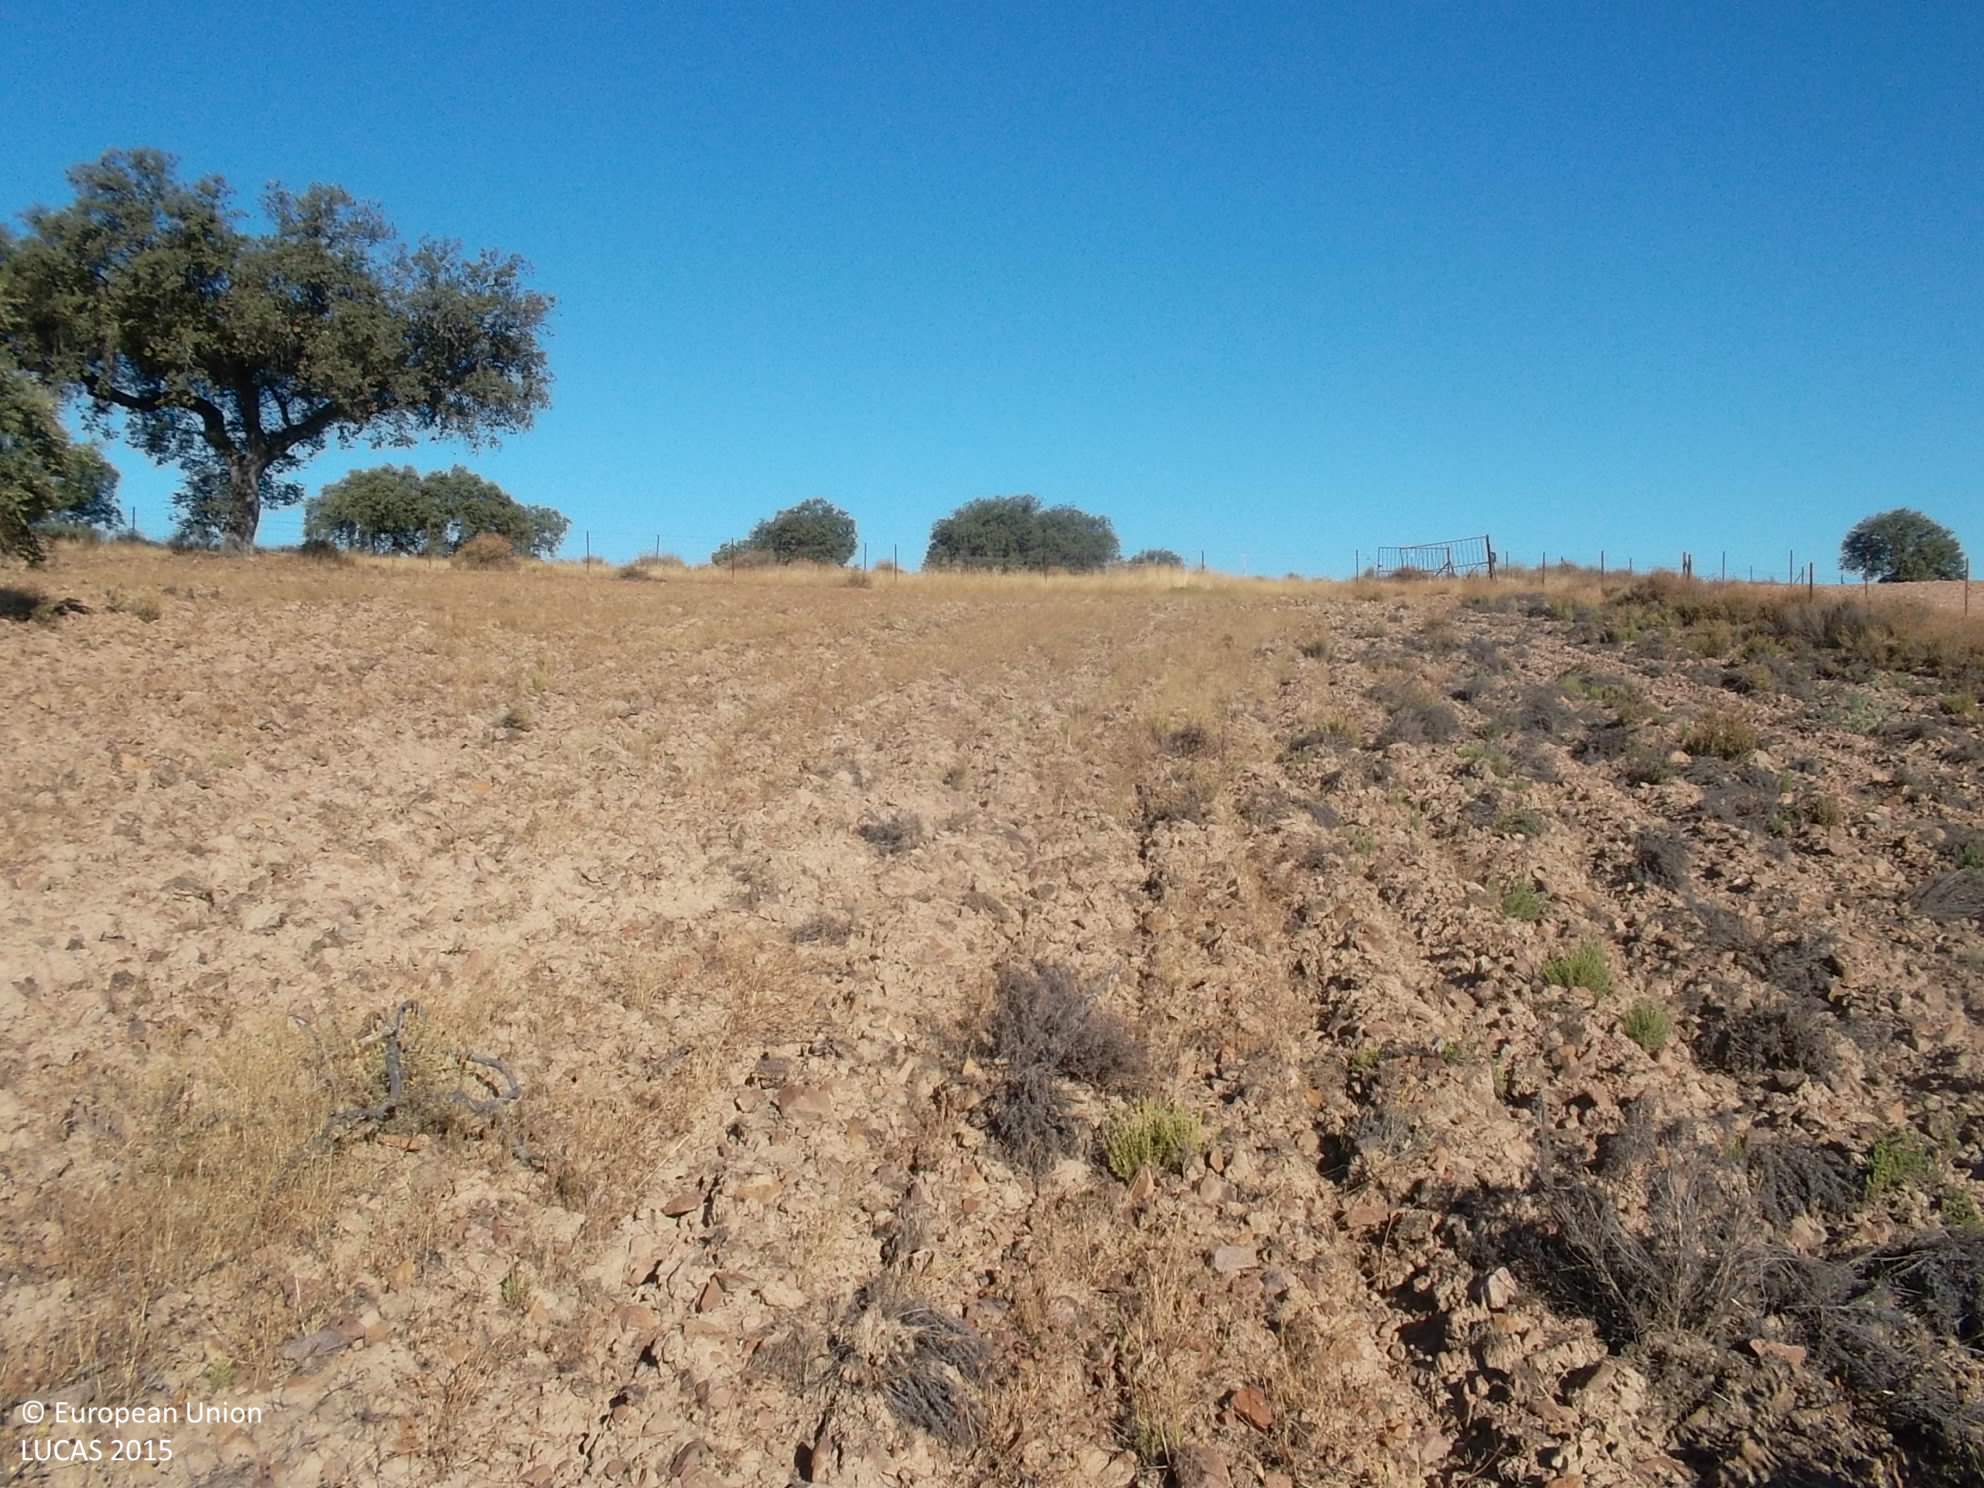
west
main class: Woodland
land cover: Broadleaved woodland
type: broadleaved evergreen forest
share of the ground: 10 - 25 %
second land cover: Grassland without tree/shrub cover
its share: 10 - 25 %
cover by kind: herbaceous plants 80 %, broadleaved forest trees 20 %
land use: Forestry
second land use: Agriculture (excluding fallow land and kitchen gardens)
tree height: > 5 m
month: July
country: ES
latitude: 38.4909
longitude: -5.8513
